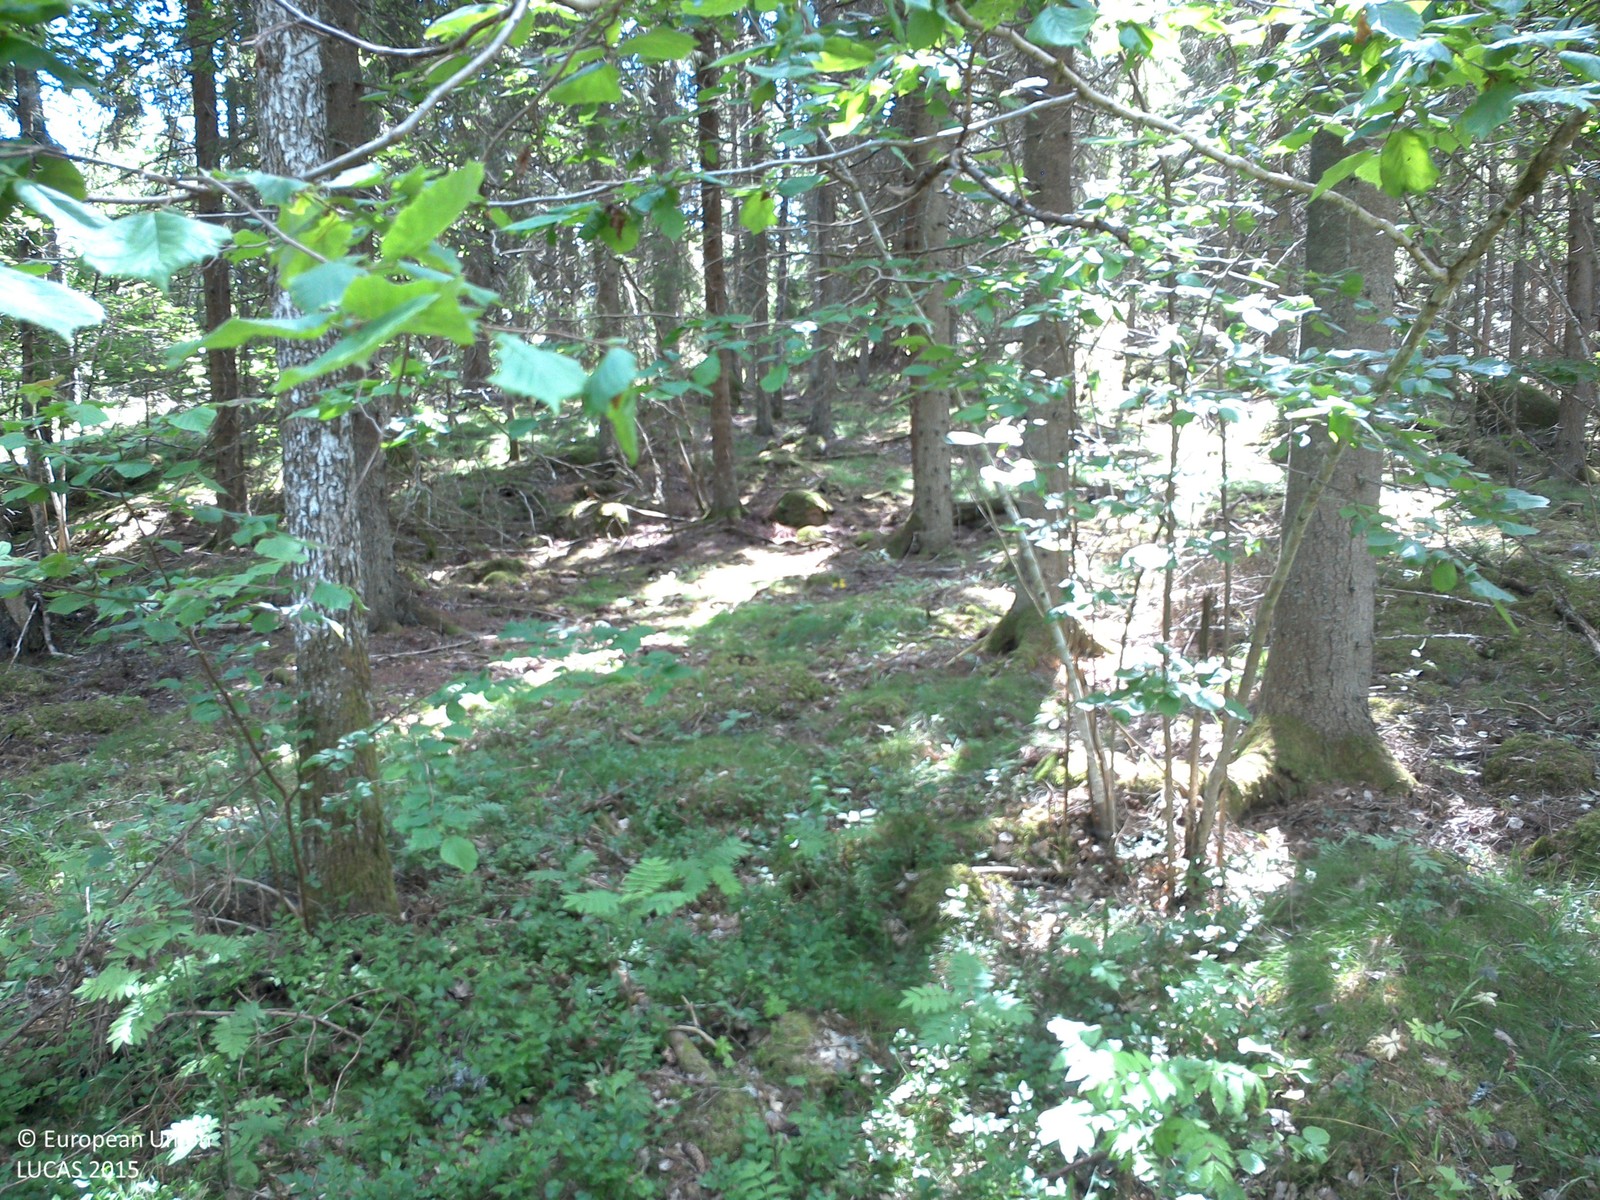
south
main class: Woodland
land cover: Spruce dominated mixed woodland
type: boreal forest
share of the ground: 50 - 75 %
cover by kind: coniferous forest trees 50 %, broadleaved forest trees 20 %, herbaceous plants 20 %, shrubs 10 %
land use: Forestry
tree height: > 5 m
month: July
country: SE
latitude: 58.0453
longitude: 14.7550
